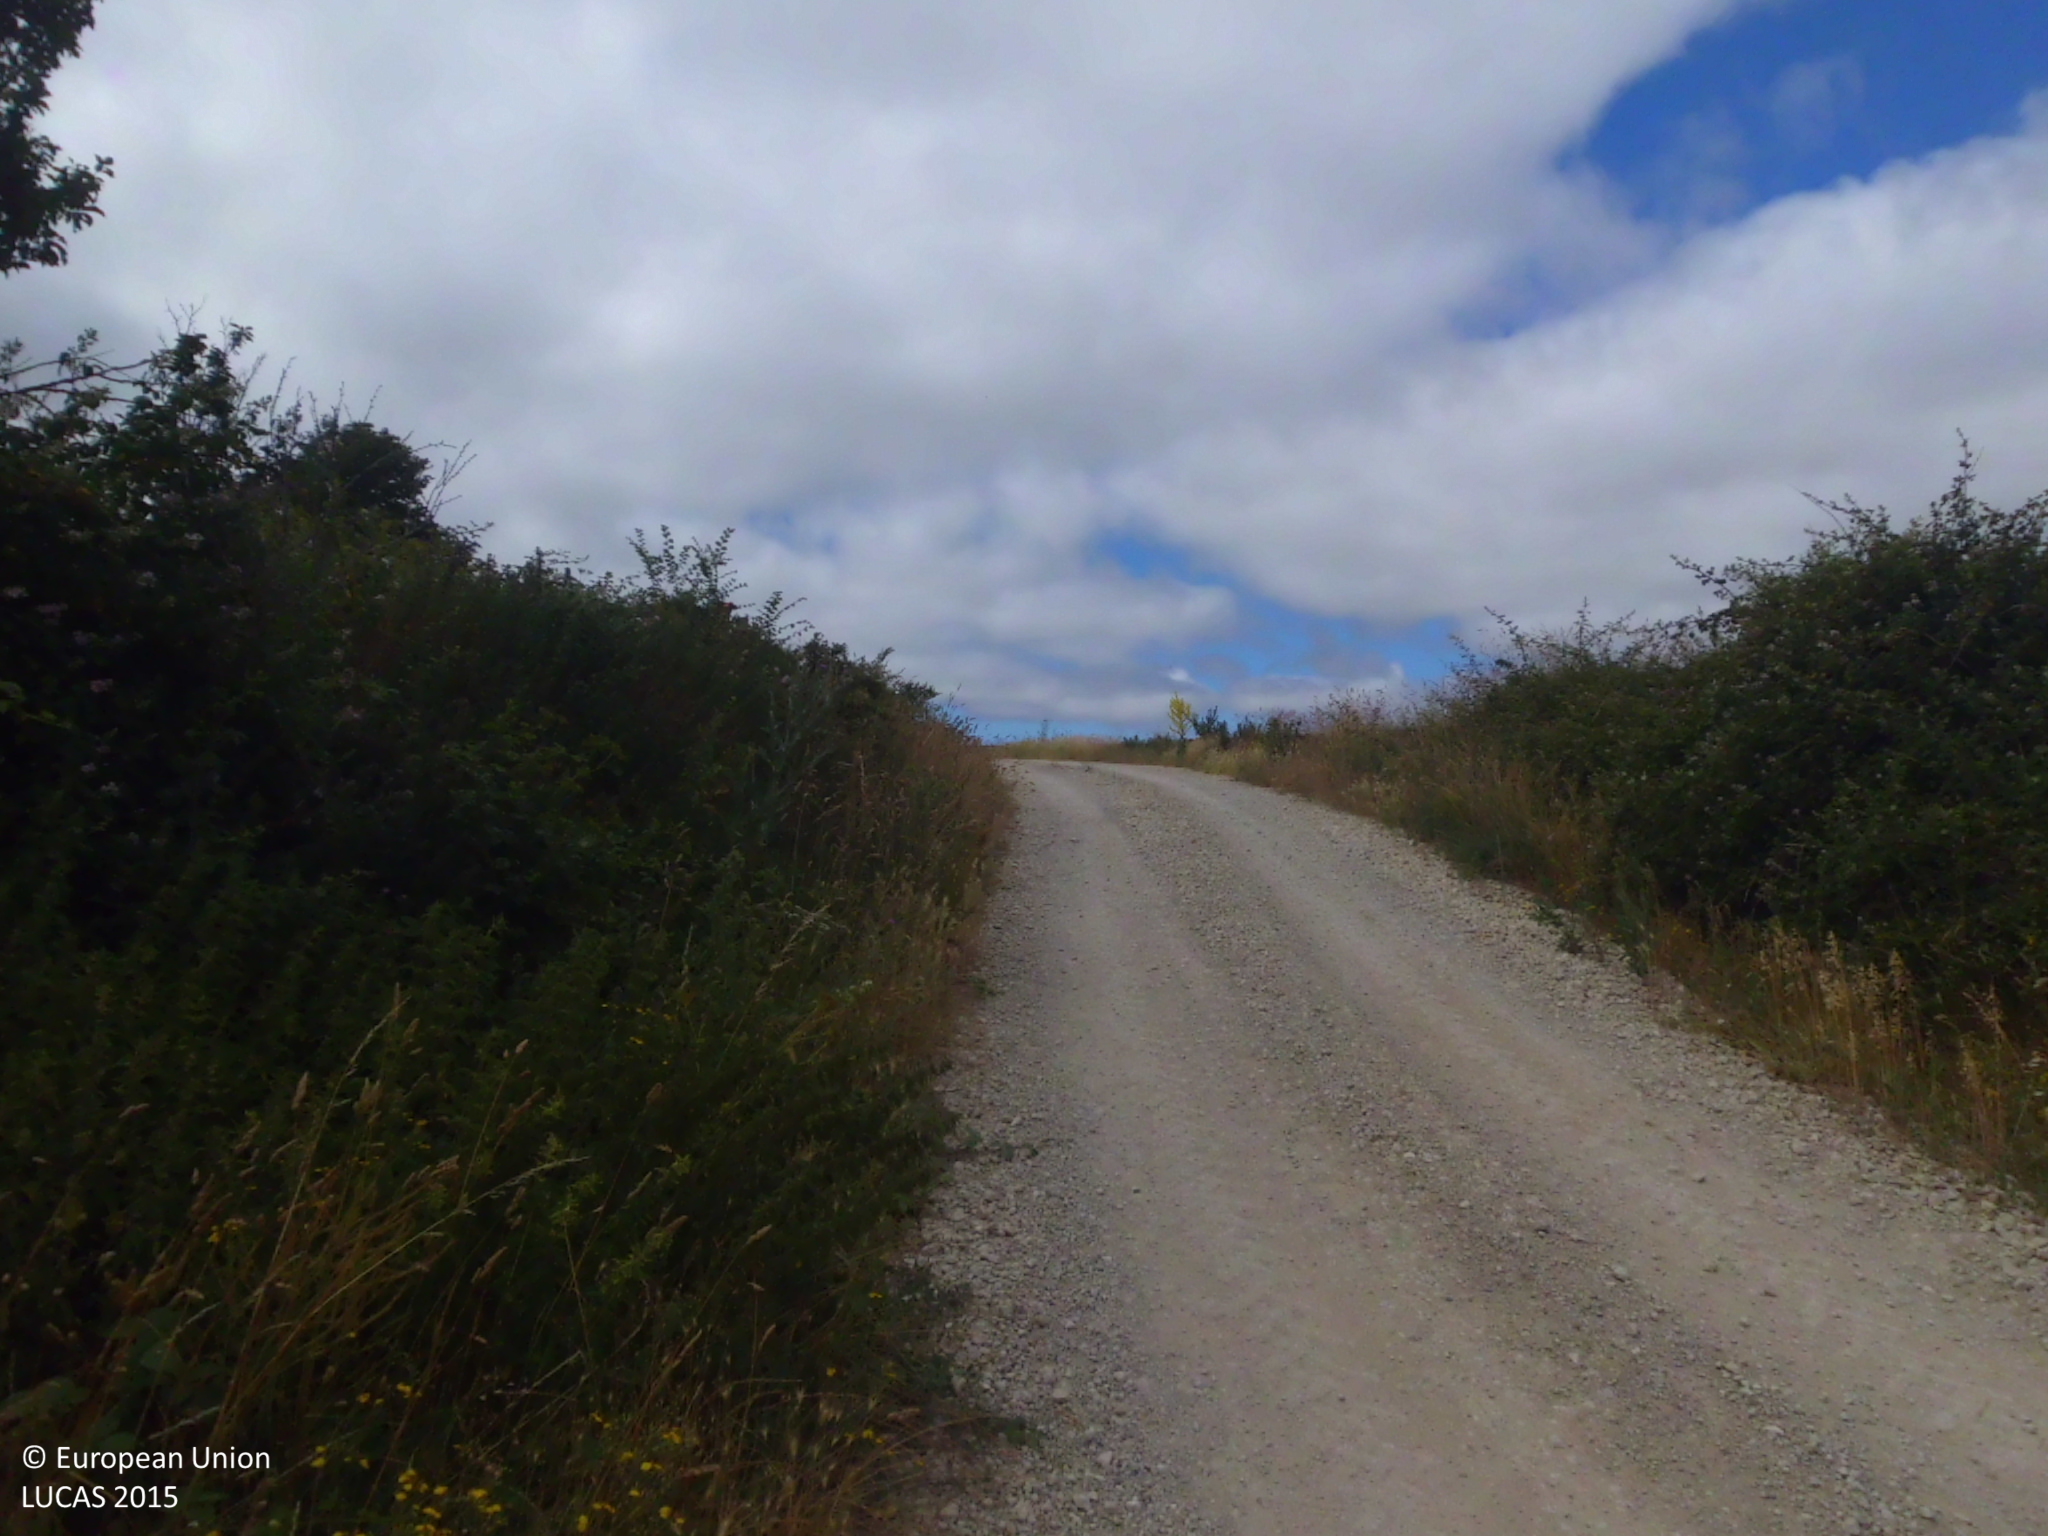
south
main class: Shrubland
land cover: Shrubland with sparse tree cover
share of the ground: 25 - 50 %
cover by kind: herbaceous plants 40 %, consolidated bare surface 30 %, shrubs 25 %, broadleaved forest trees 5 %
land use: Abandoned areas
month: July
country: ES
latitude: 42.7300
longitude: -4.0547
